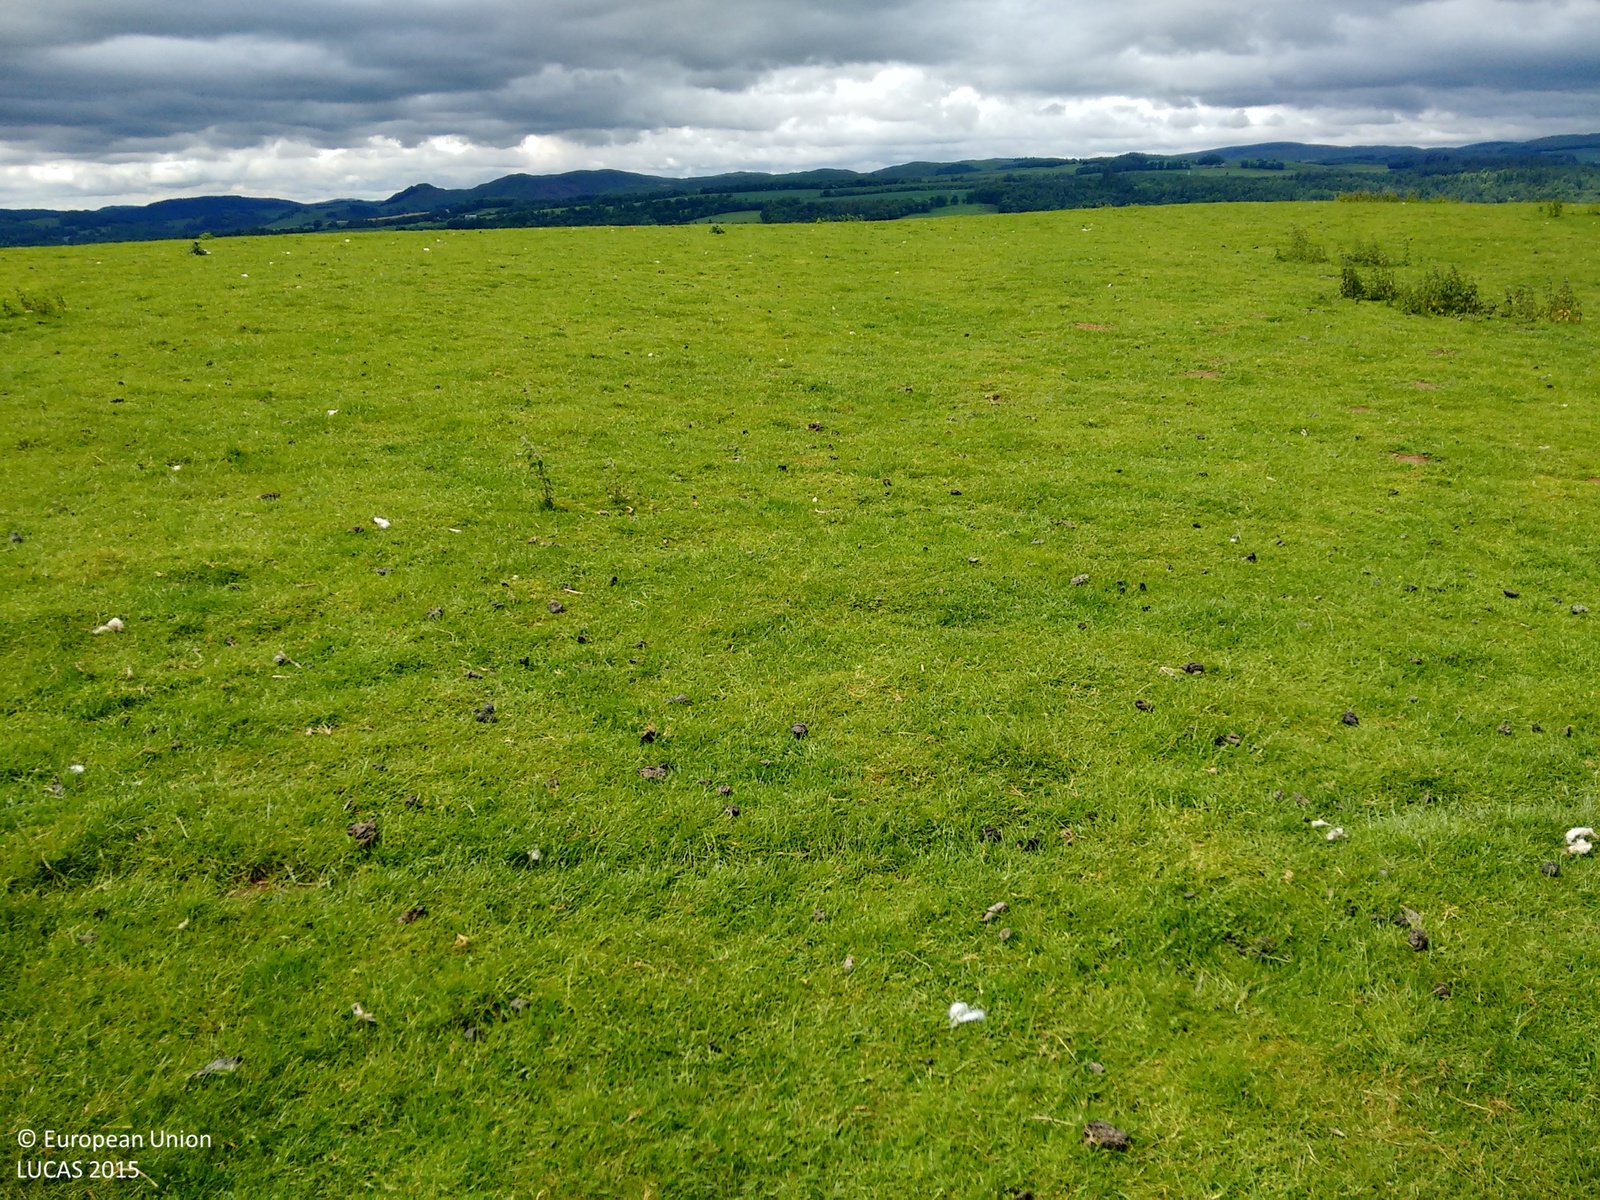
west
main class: Grassland
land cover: Grassland without tree/shrub cover
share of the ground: > 75 %
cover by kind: herbaceous plants 100 %
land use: Agriculture (excluding fallow land and kitchen gardens)
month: June
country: GB
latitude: 55.2591
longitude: -3.7584
